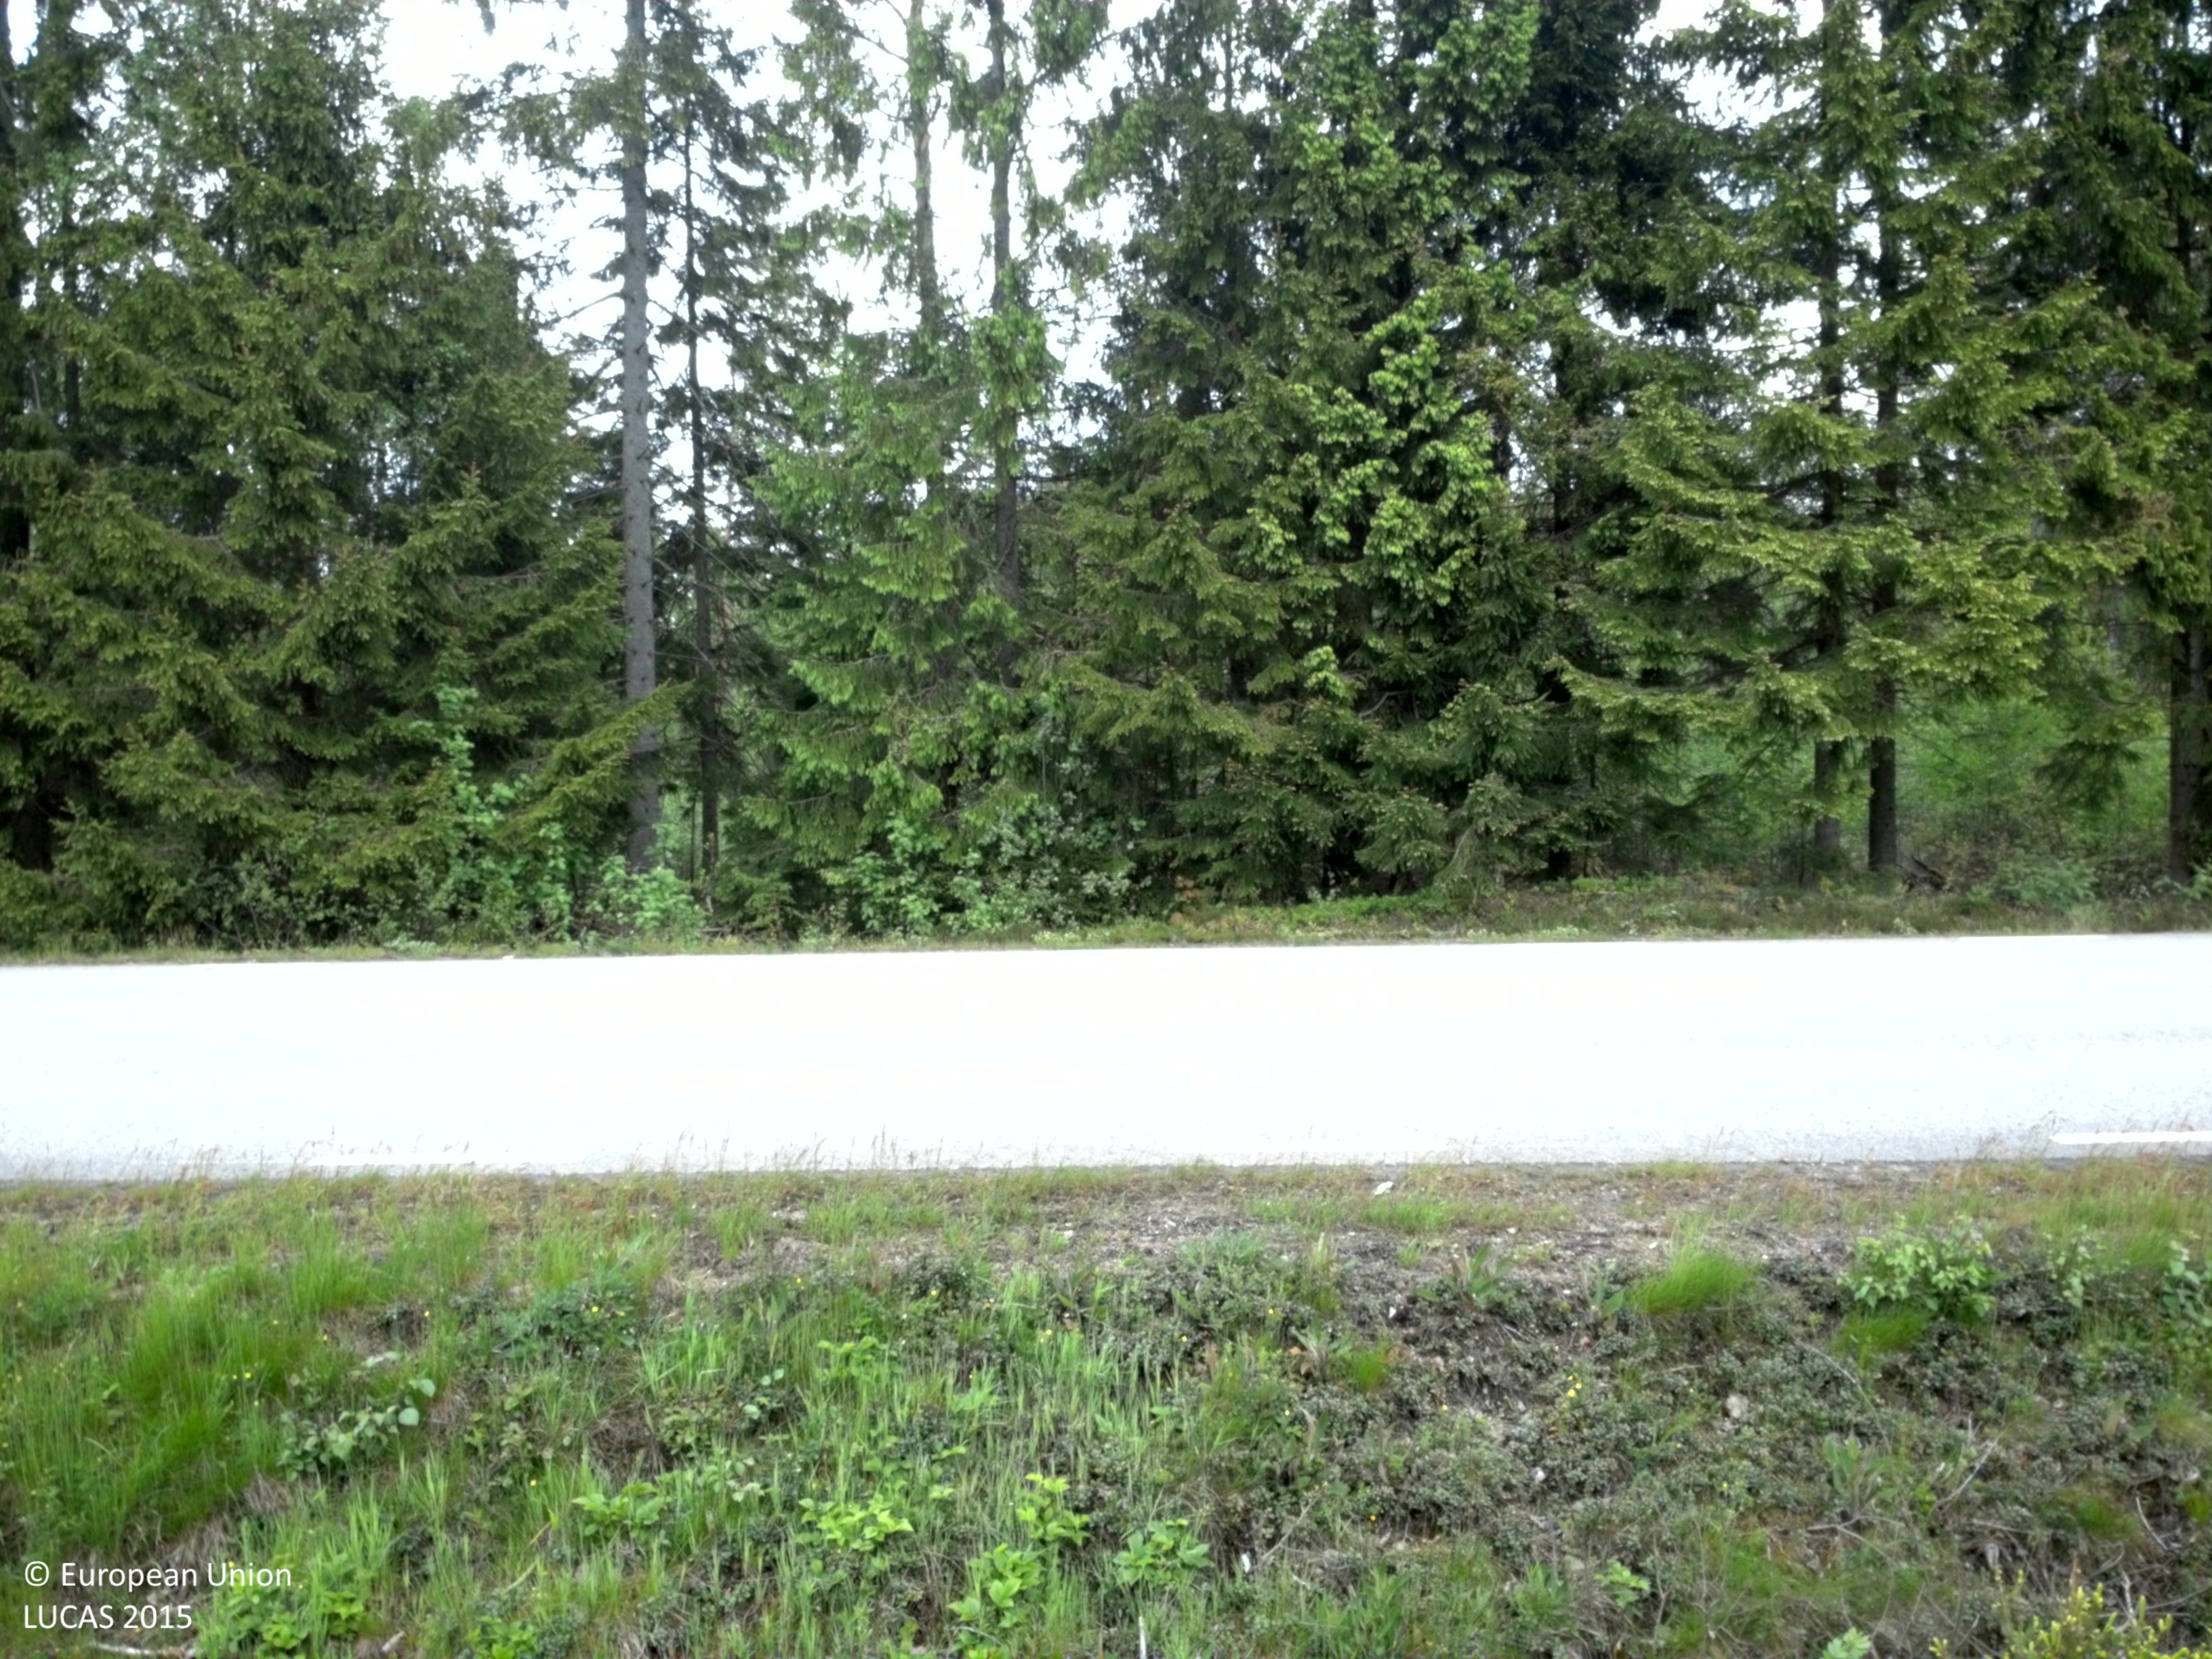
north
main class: Woodland
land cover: Spruce dominated mixed woodland
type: boreal forest
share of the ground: 50 - 75 %
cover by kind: broadleaved forest trees 35 %, coniferous forest trees 25 %, herbaceous plants 25 %, shrubs 10 %, lichens and mosses 5 %
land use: Forestry
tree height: < 5 m
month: June
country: SE
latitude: 56.8178
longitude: 14.3054
